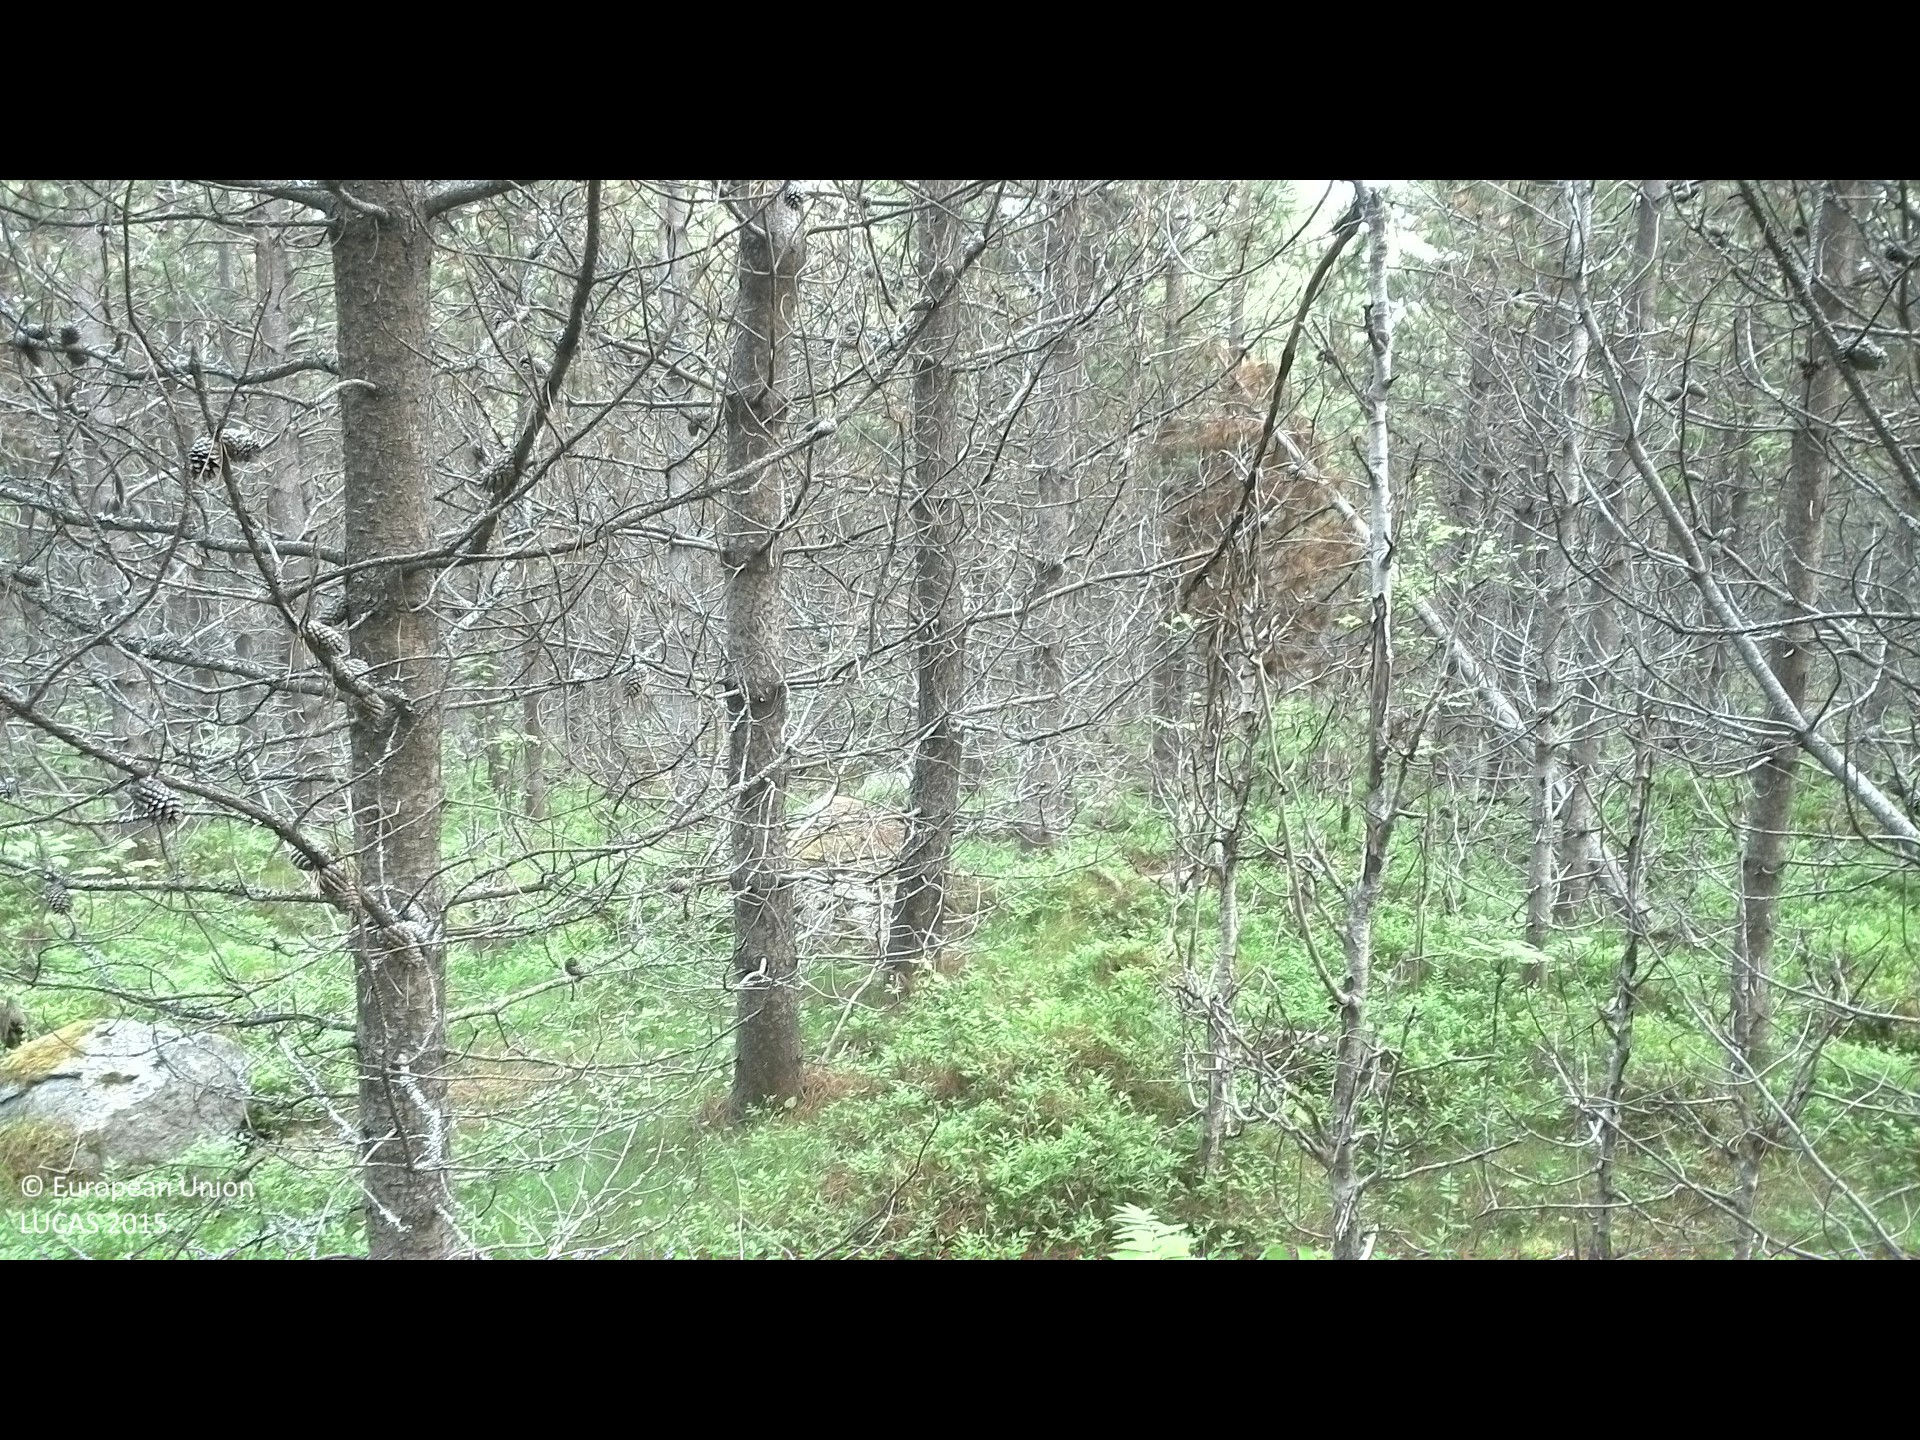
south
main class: Woodland
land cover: Pine dominated coniferous woodland
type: exotic forest
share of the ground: 50 - 75 %
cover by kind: coniferous forest trees 50 %, shrubs 40 %, lichens and mosses 10 %
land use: Forestry
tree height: > 5 m
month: June
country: SE
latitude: 62.0622
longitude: 16.3526
